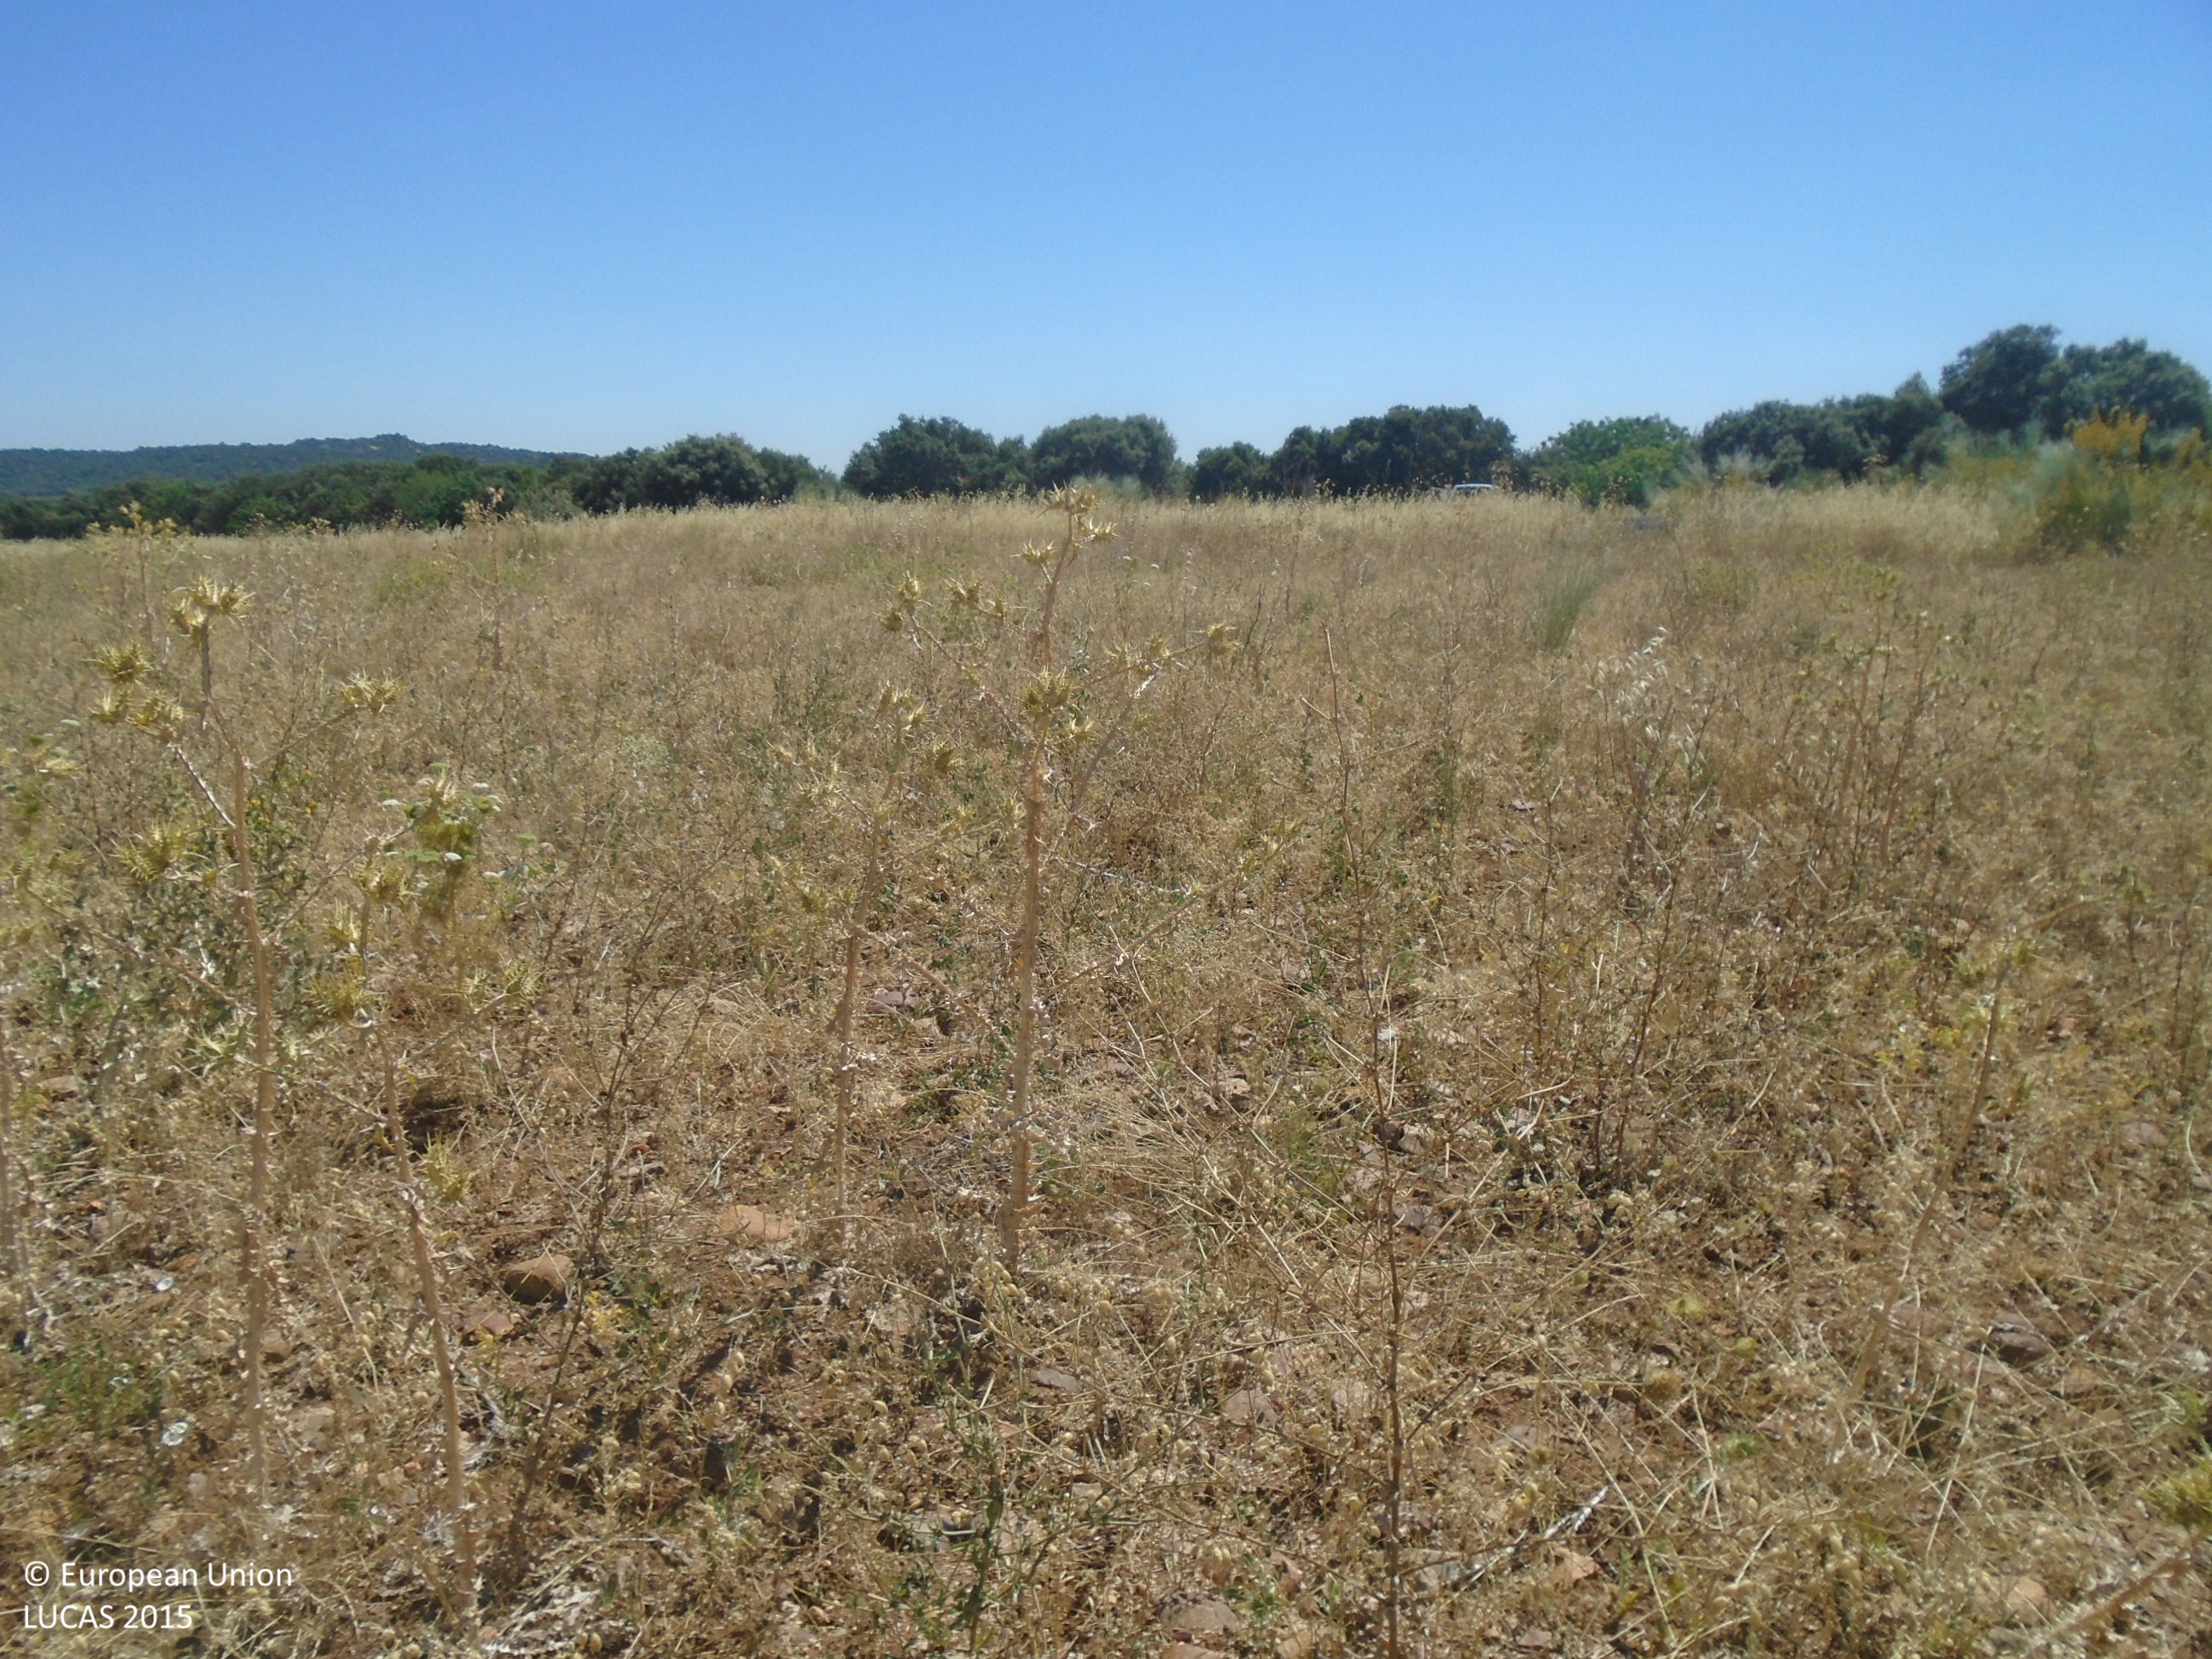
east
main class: Grassland
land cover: Spontaneously vegetated surfaces
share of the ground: > 75 %
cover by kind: herbaceous plants 100 %
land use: Fallow land
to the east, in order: Spontaneously vegetated surfaces; Ditches and canals; Grass margins; Paved roads, cycling and walking lanes; Grass margins; Ditches and canals; Abandoned hedges; Grass margins; Paved roads, cycling and walking lanes; Grass margins; Abandoned hedges; Oats
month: July
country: ES
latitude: 39.7711
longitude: -5.0976
